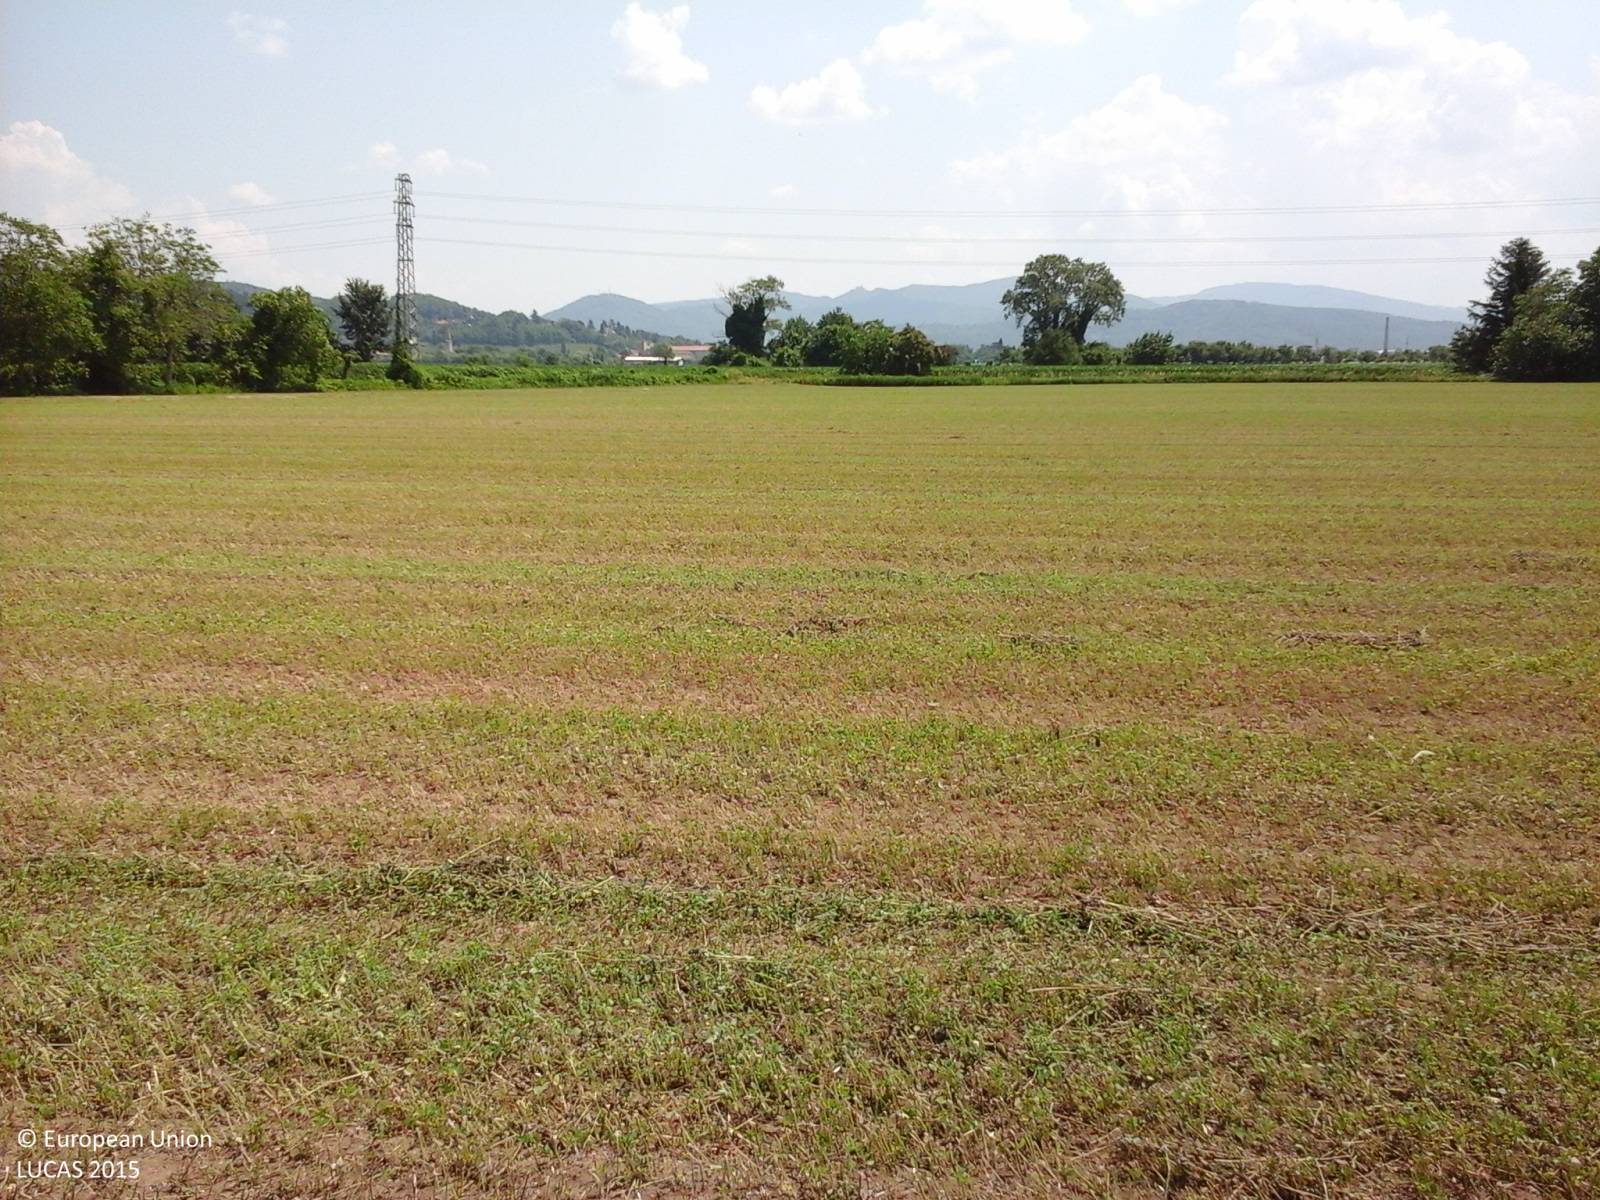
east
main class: Cropland
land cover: Other leguminous and mixtures for fodder
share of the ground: > 75 %
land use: Agriculture (excluding fallow land and kitchen gardens)
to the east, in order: Other leguminous and mixtures for fodder; Electric lines; Other leguminous and mixtures for fodder; Grass margins; Tracks; Grass margins; Ditches and canals; Grass margins; Maize; Broadleaved woodland
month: June
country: IT
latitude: 46.0989
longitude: 13.3985
